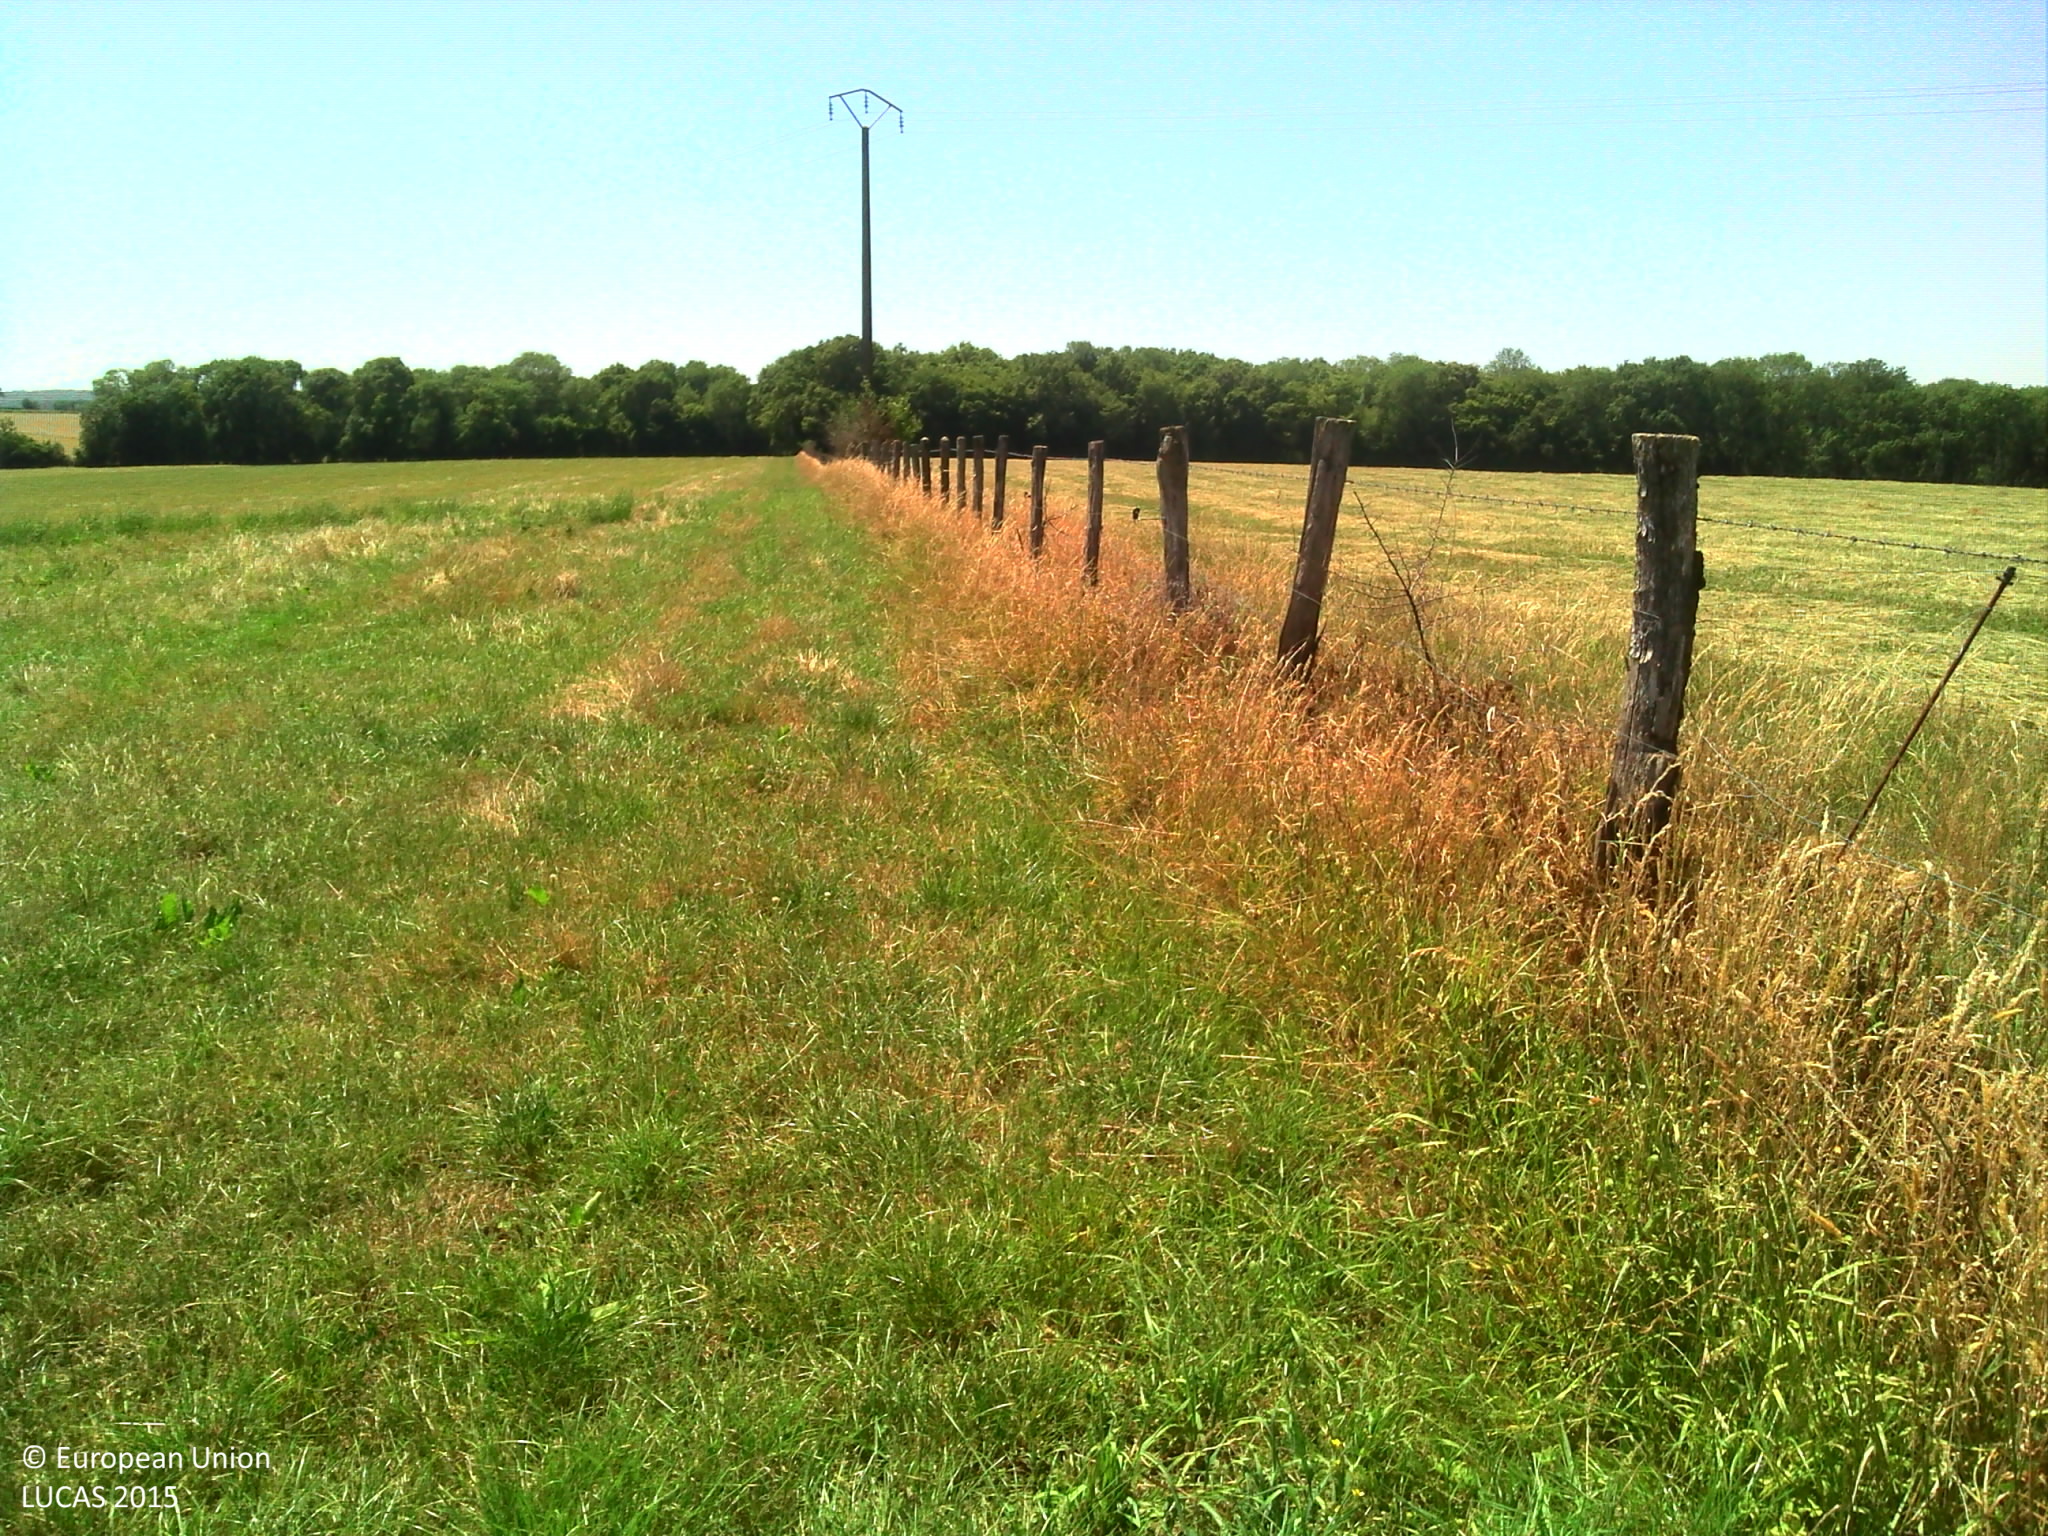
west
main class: Grassland
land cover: Grassland without tree/shrub cover
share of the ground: > 75 %
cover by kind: herbaceous plants 100 %
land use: Agriculture (excluding fallow land and kitchen gardens)
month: June
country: FR
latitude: 46.9363
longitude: 3.6010
